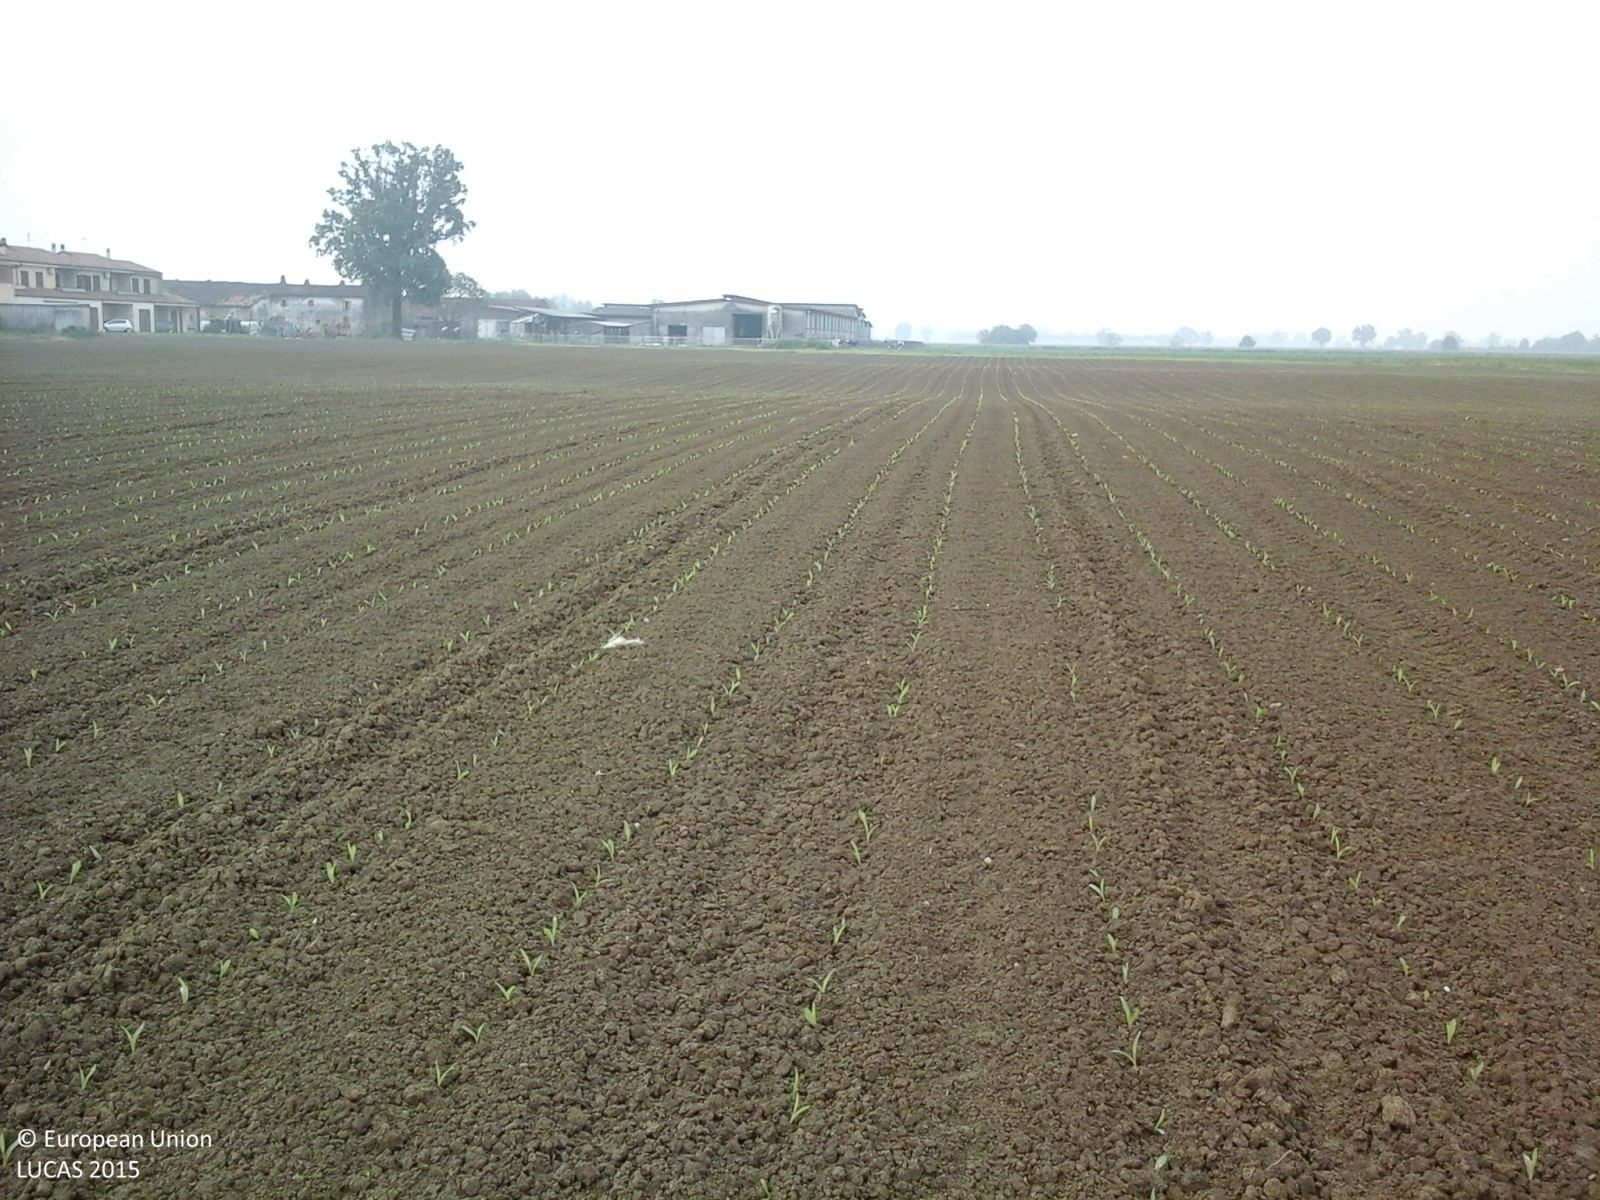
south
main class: Cropland
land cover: Maize
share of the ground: < 10 %
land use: Agriculture (excluding fallow land and kitchen gardens)
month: May
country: IT
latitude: 45.0530
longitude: 10.4182
